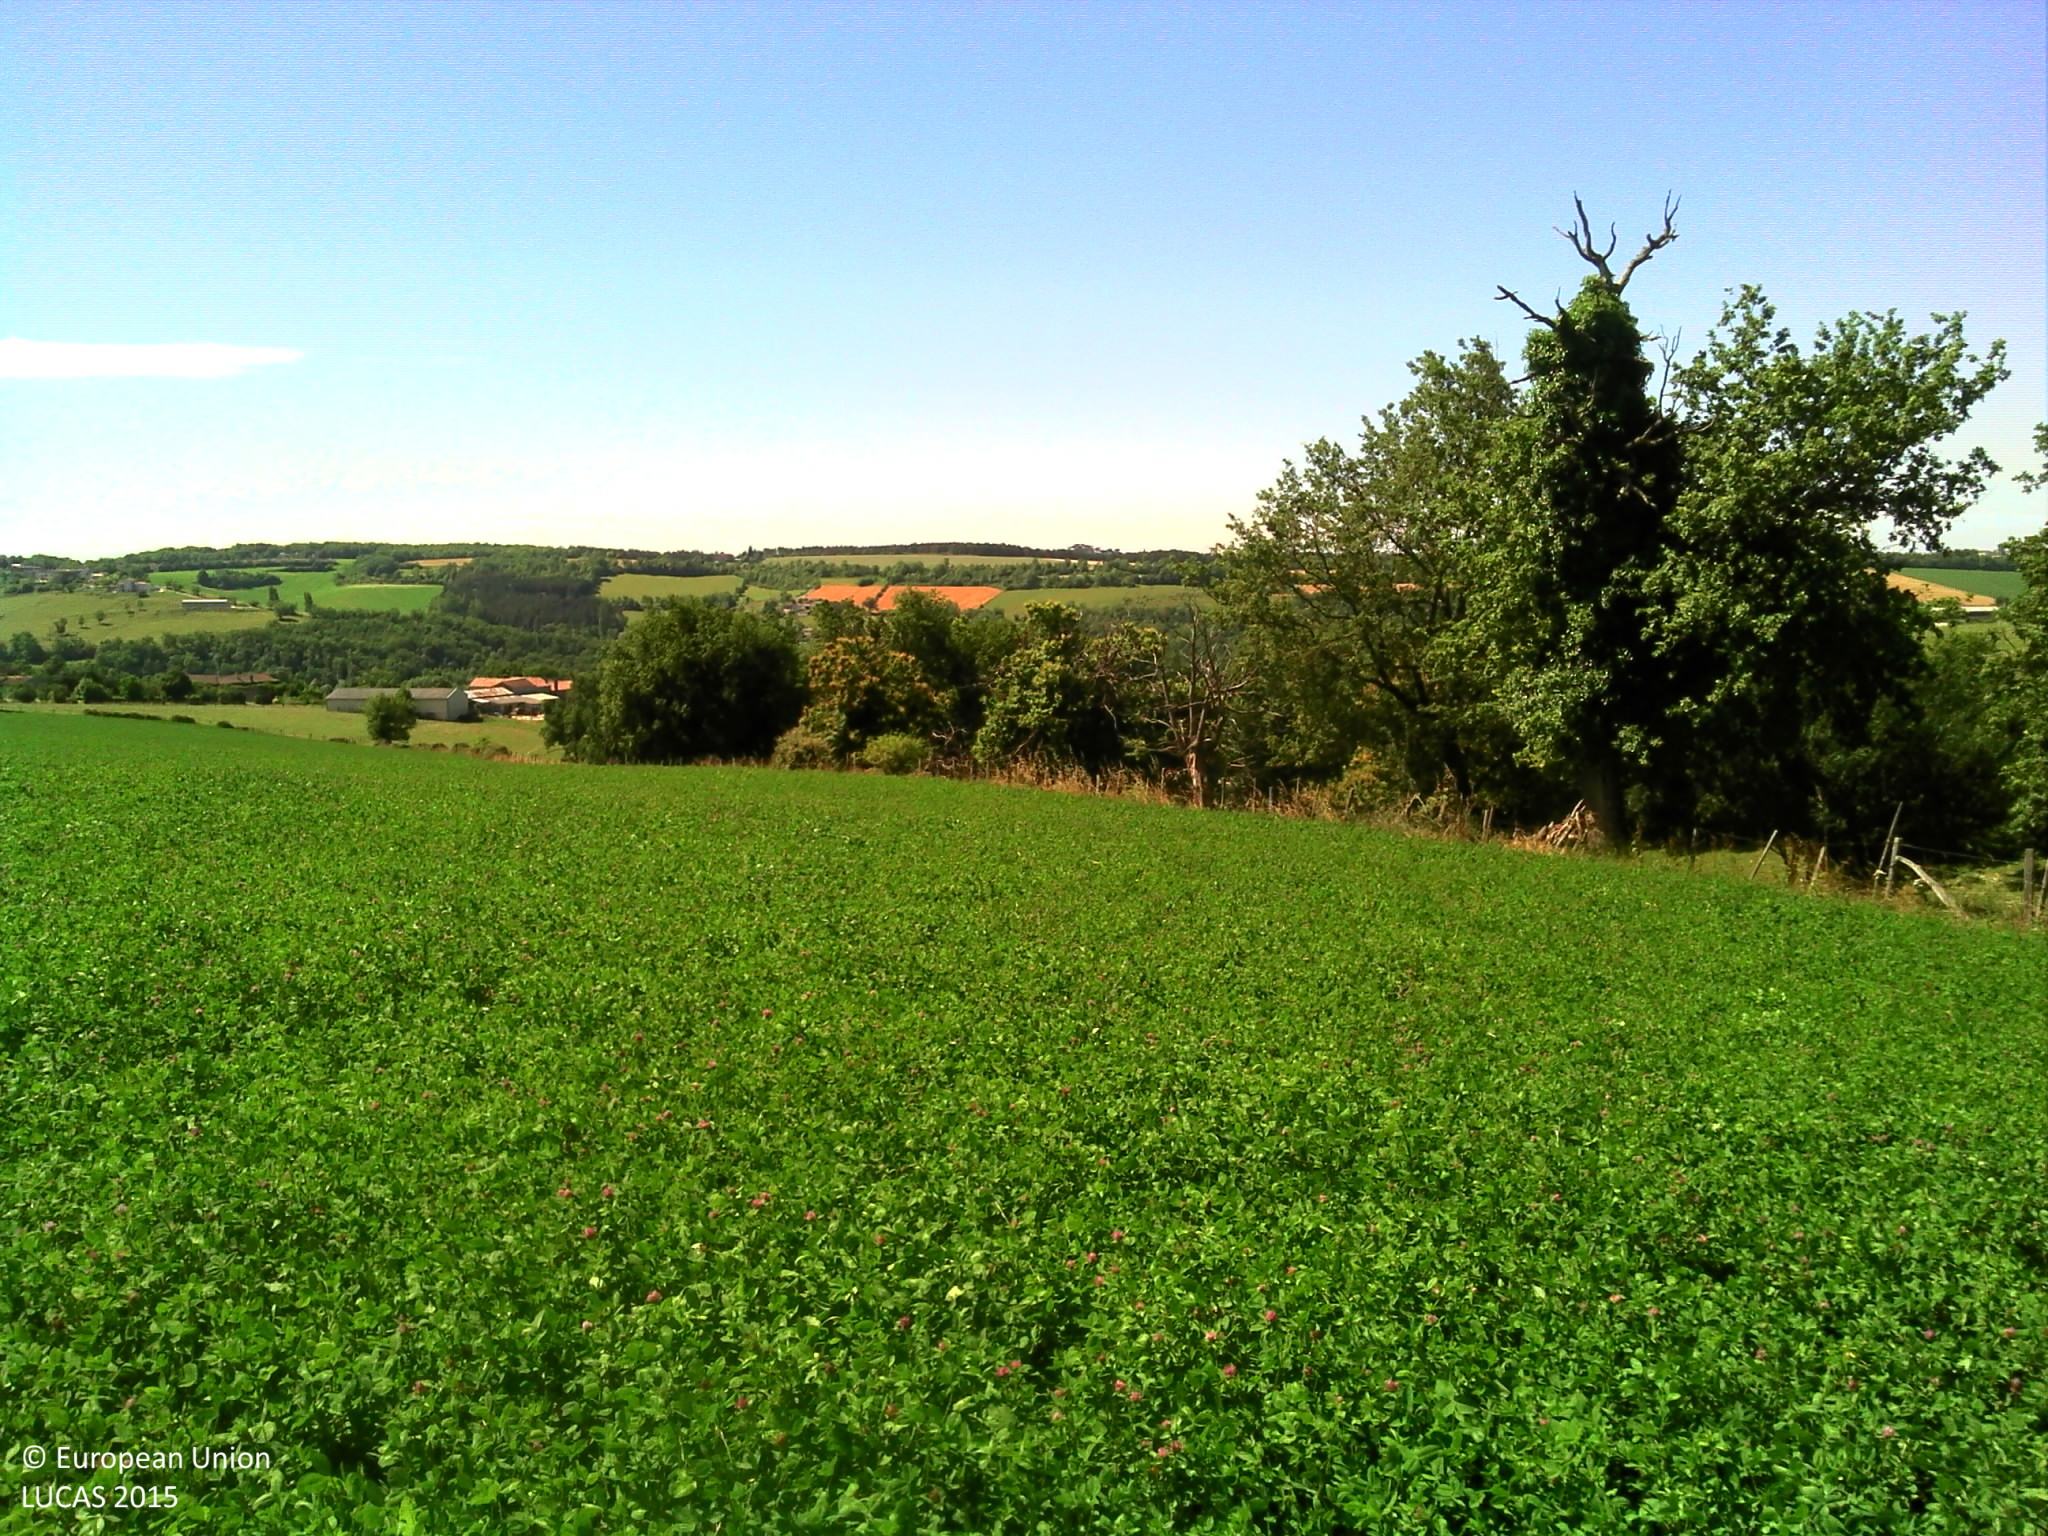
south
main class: Cropland
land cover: Clovers
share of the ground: > 75 %
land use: Agriculture (excluding fallow land and kitchen gardens)
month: June
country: FR
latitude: 44.0832
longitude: 2.0727
